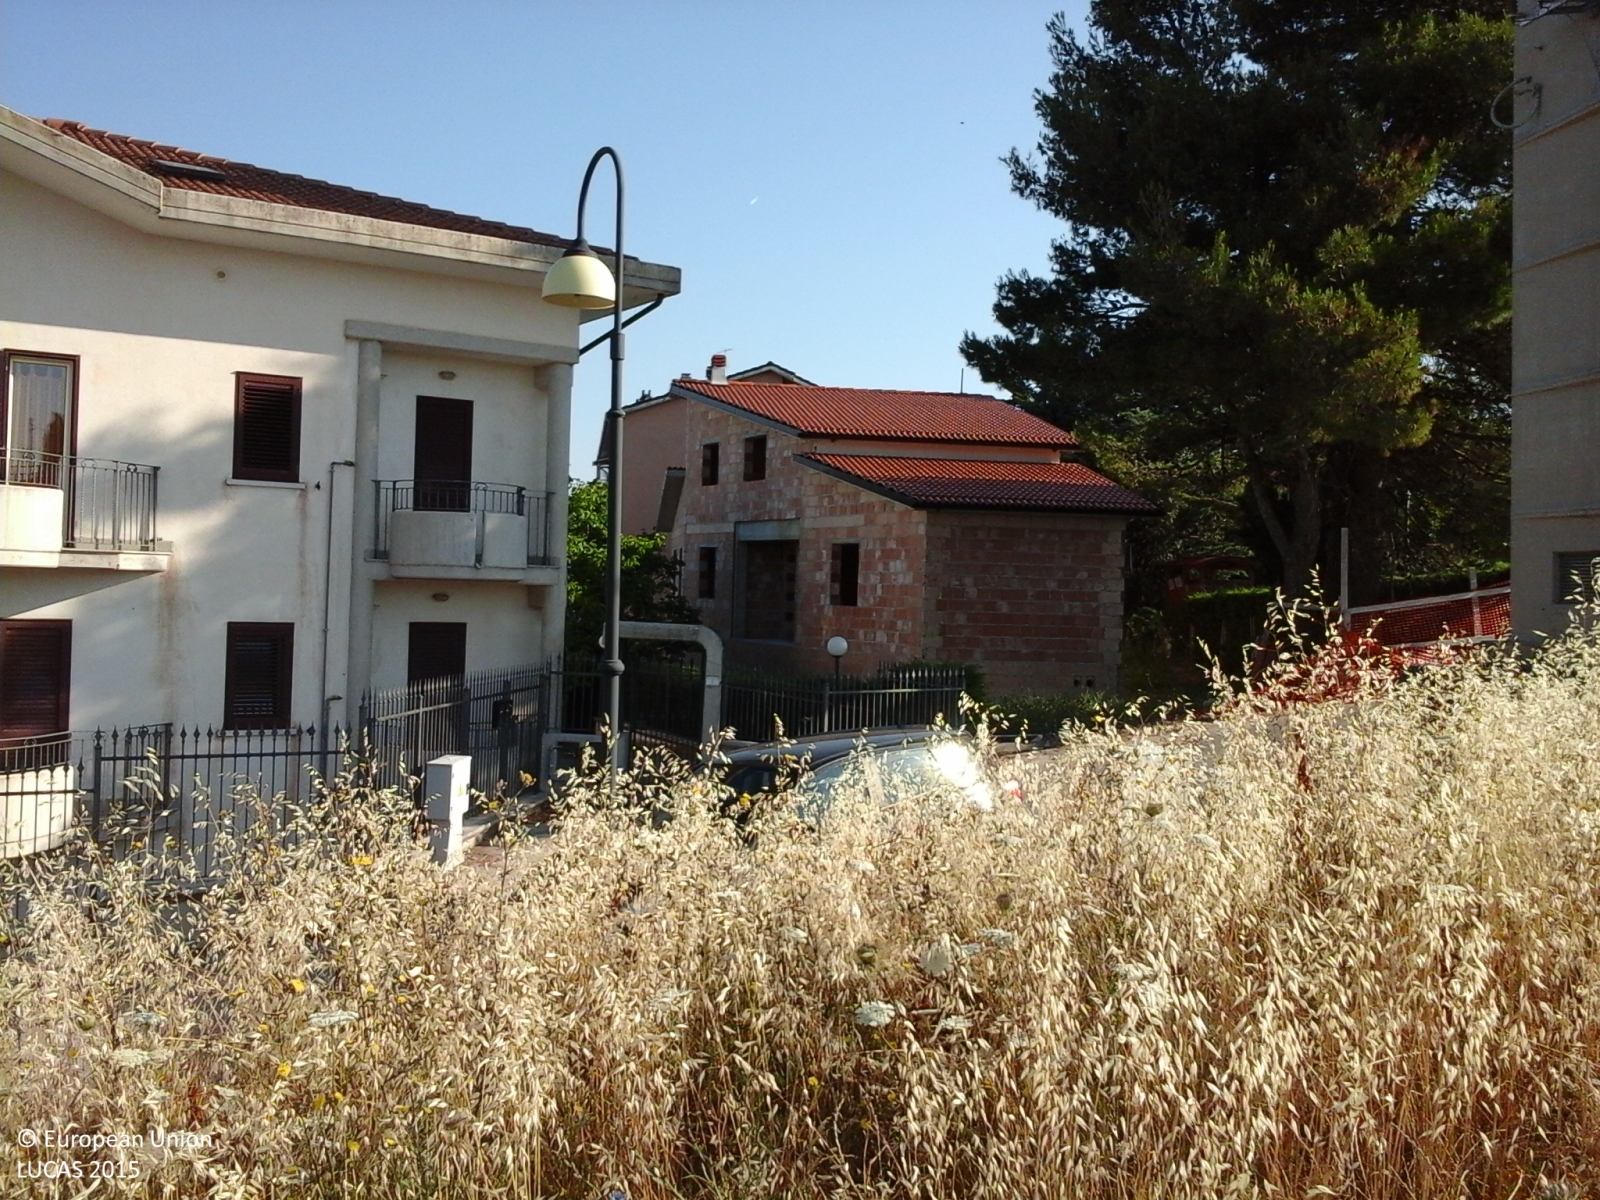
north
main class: Grassland
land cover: Spontaneously vegetated surfaces
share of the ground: > 75 %
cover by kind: herbaceous plants 100 %
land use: Fallow land
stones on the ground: < 10 %
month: July
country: IT
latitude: 41.6412
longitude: 14.6782
